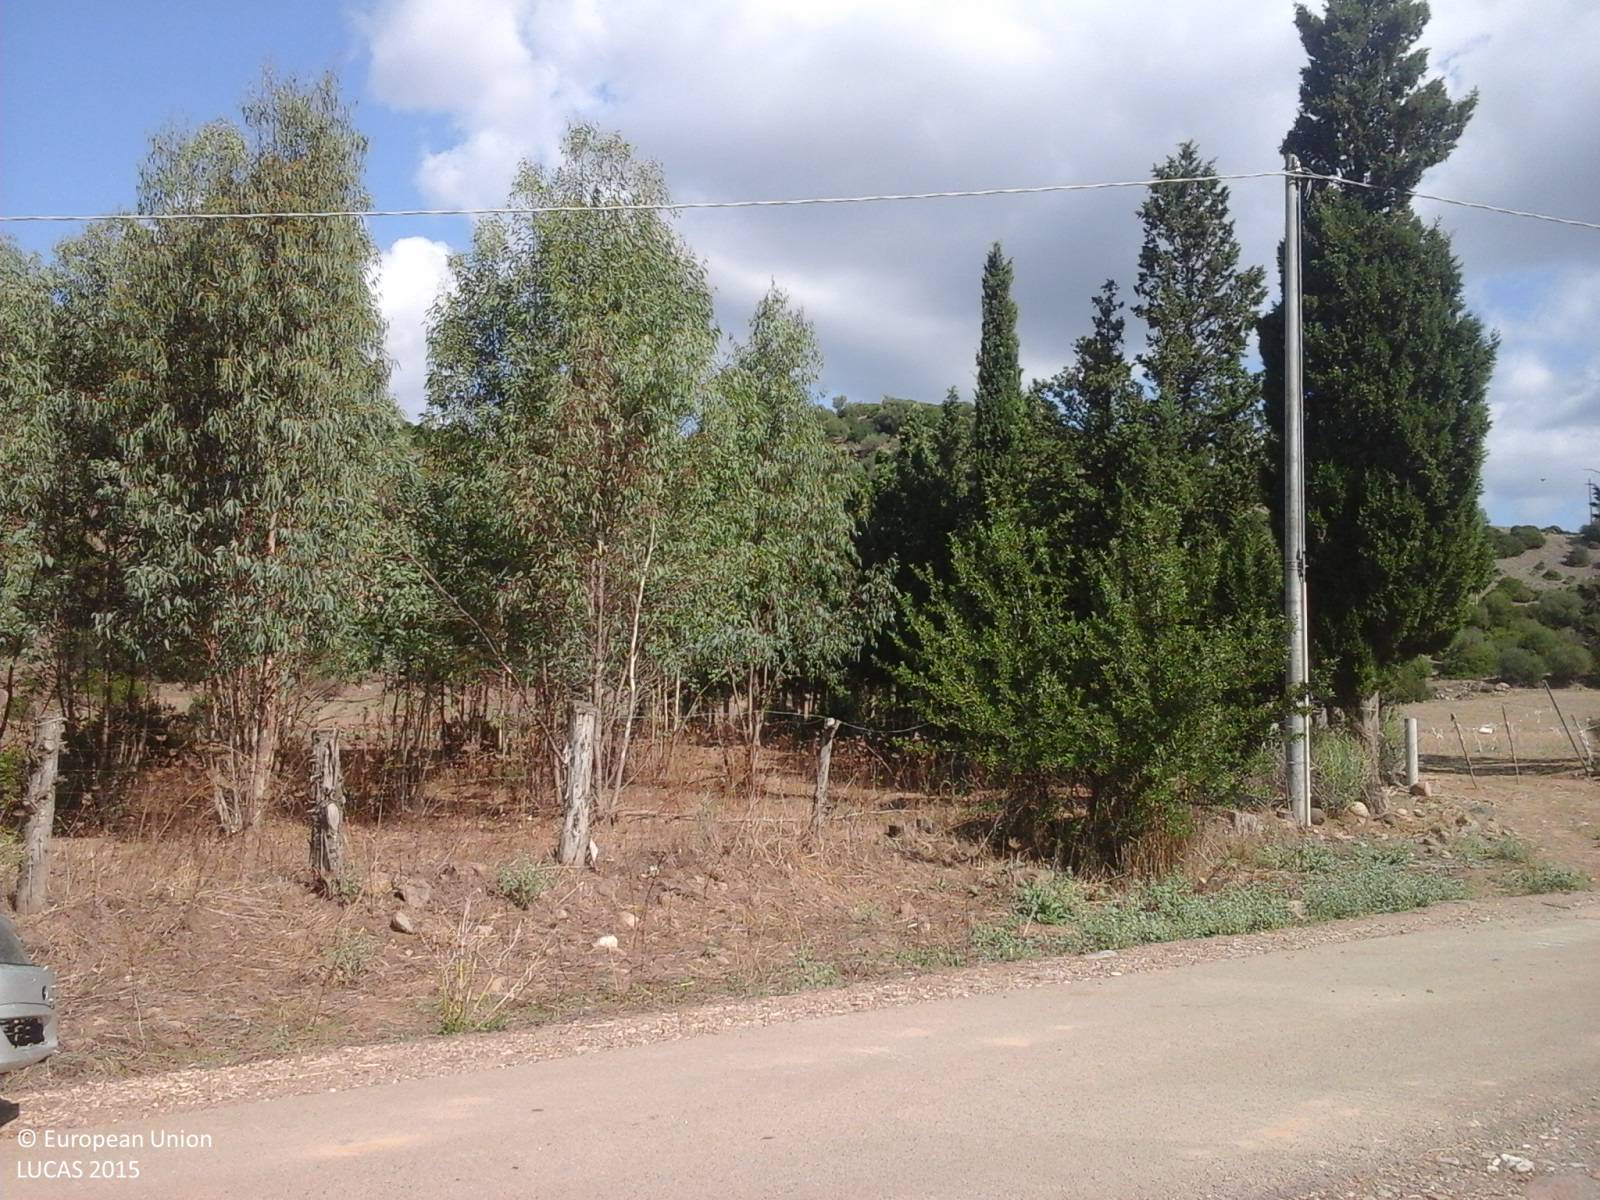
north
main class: Shrubland
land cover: Shrubland with sparse tree cover
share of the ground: > 75 %
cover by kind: shrubs 65 %, herbaceous plants 15 %, unconsolidated bare surface 15 %, broadleaved forest trees 5 %
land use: Agriculture (excluding fallow land and kitchen gardens)
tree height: > 5 m
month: August
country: IT
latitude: 39.5591
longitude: 9.3868
